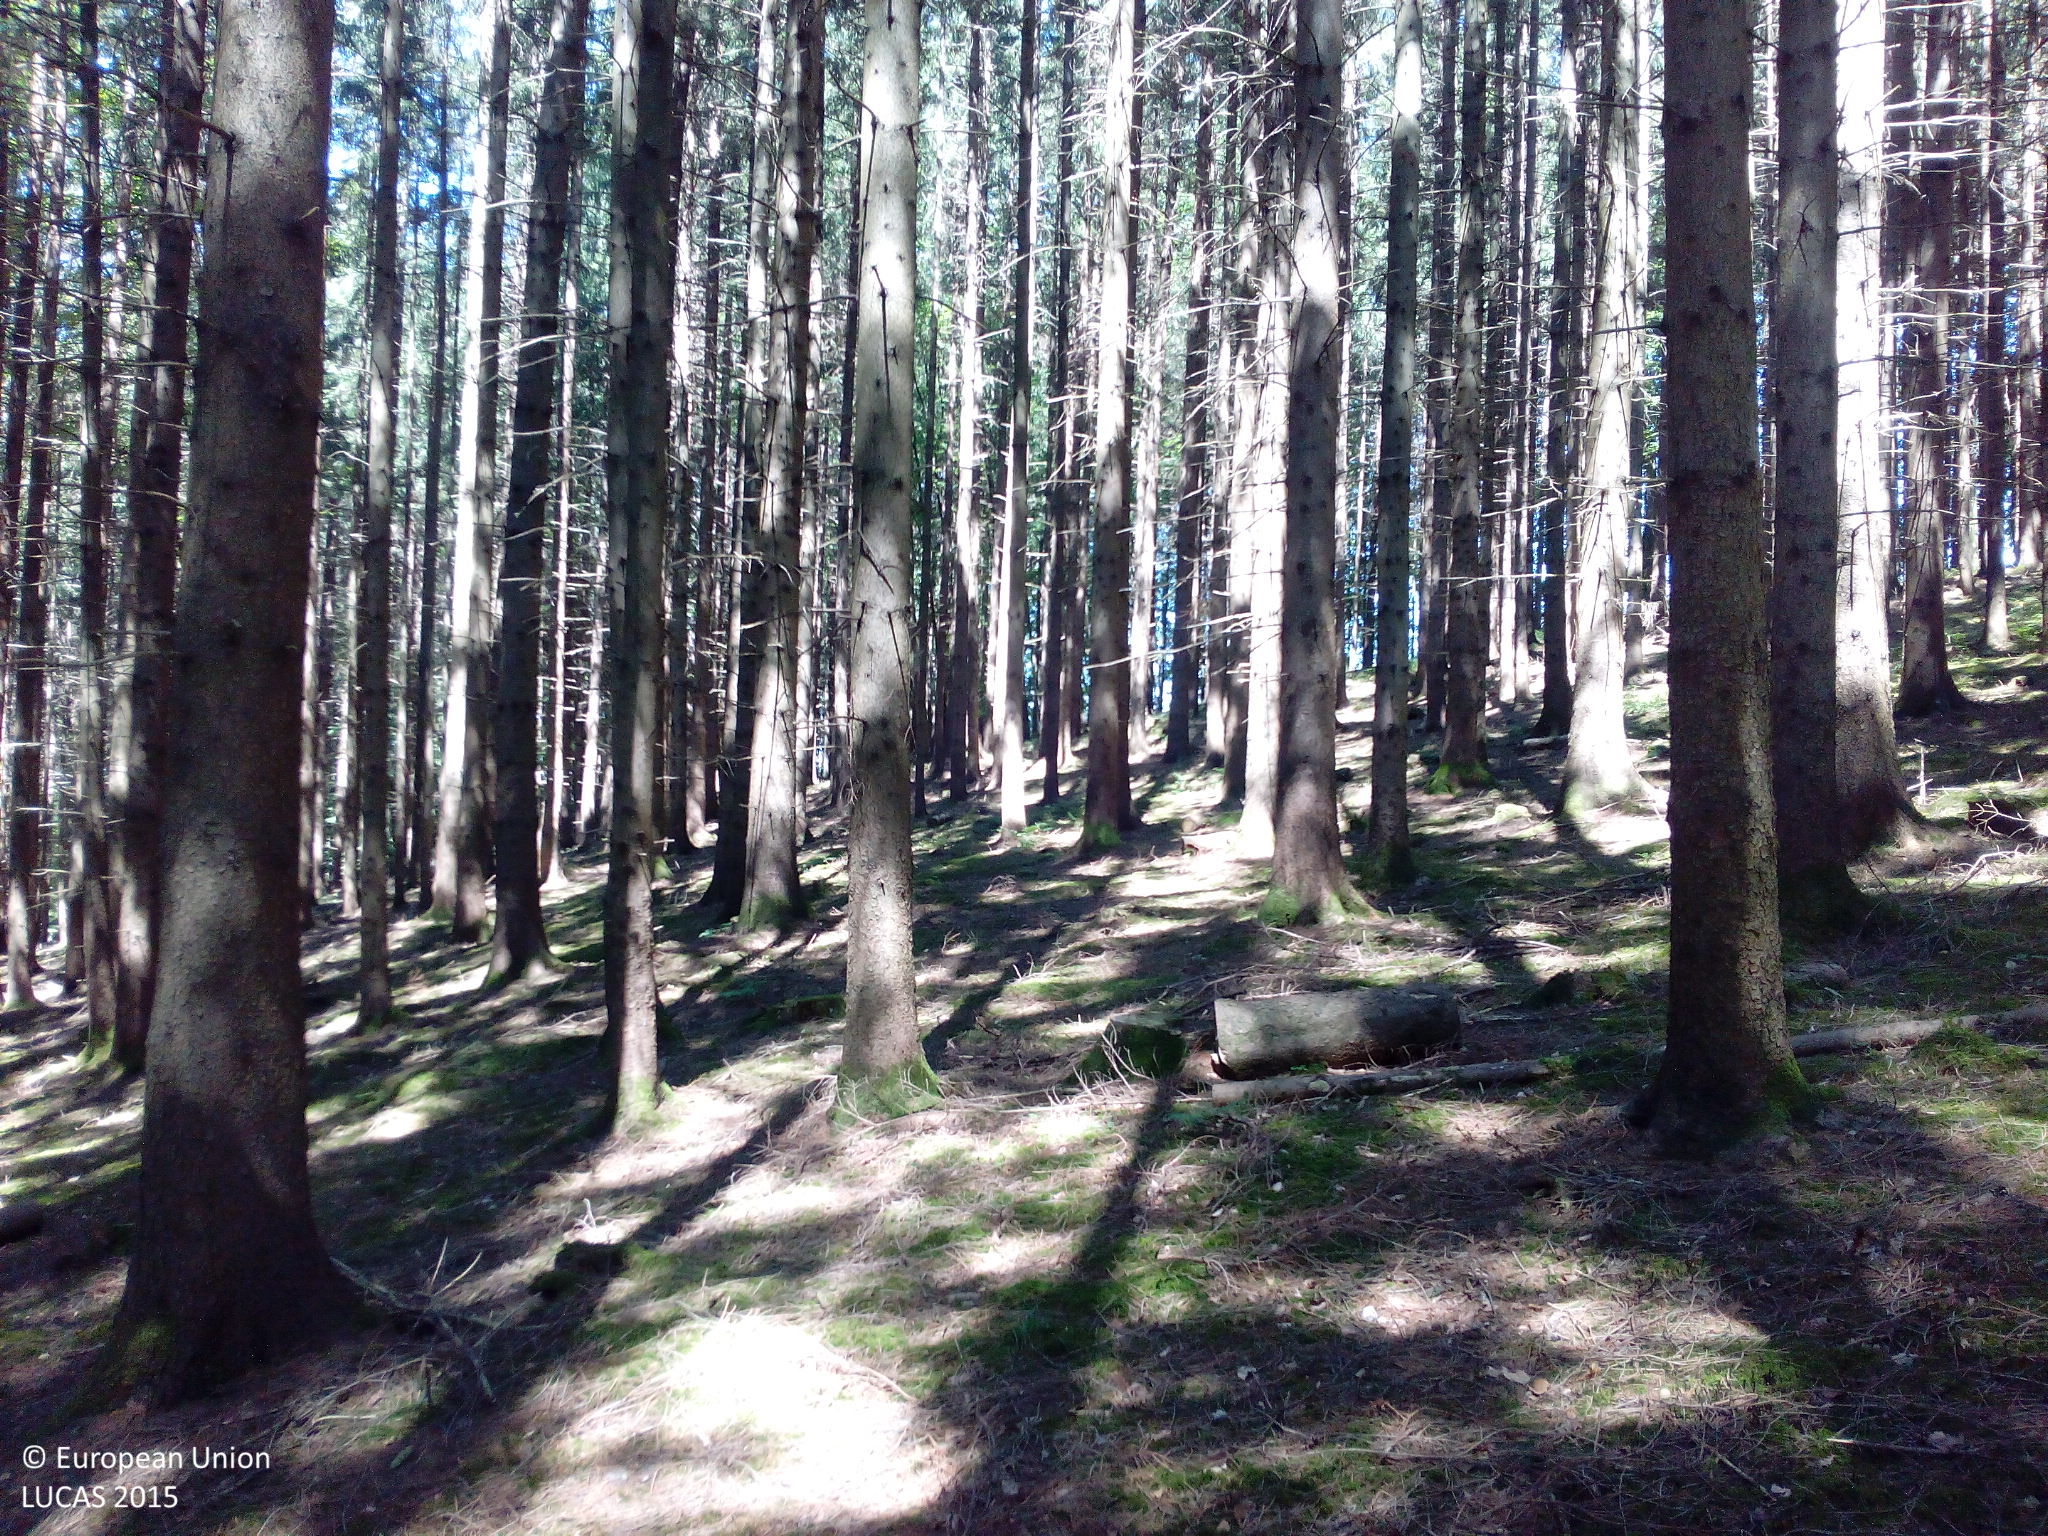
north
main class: Woodland
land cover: Spruce dominated coniferous woodland
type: hemiboreal forest and nemoral coniferous forest and mixed broadleaved-coniferous forest
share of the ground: > 75 %
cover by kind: coniferous forest trees 90 %, broadleaved forest trees 5 %, unconsolidated bare surface 5 %
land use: Forestry
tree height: > 5 m
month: August
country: DE
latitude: 47.9540
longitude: 12.7974
